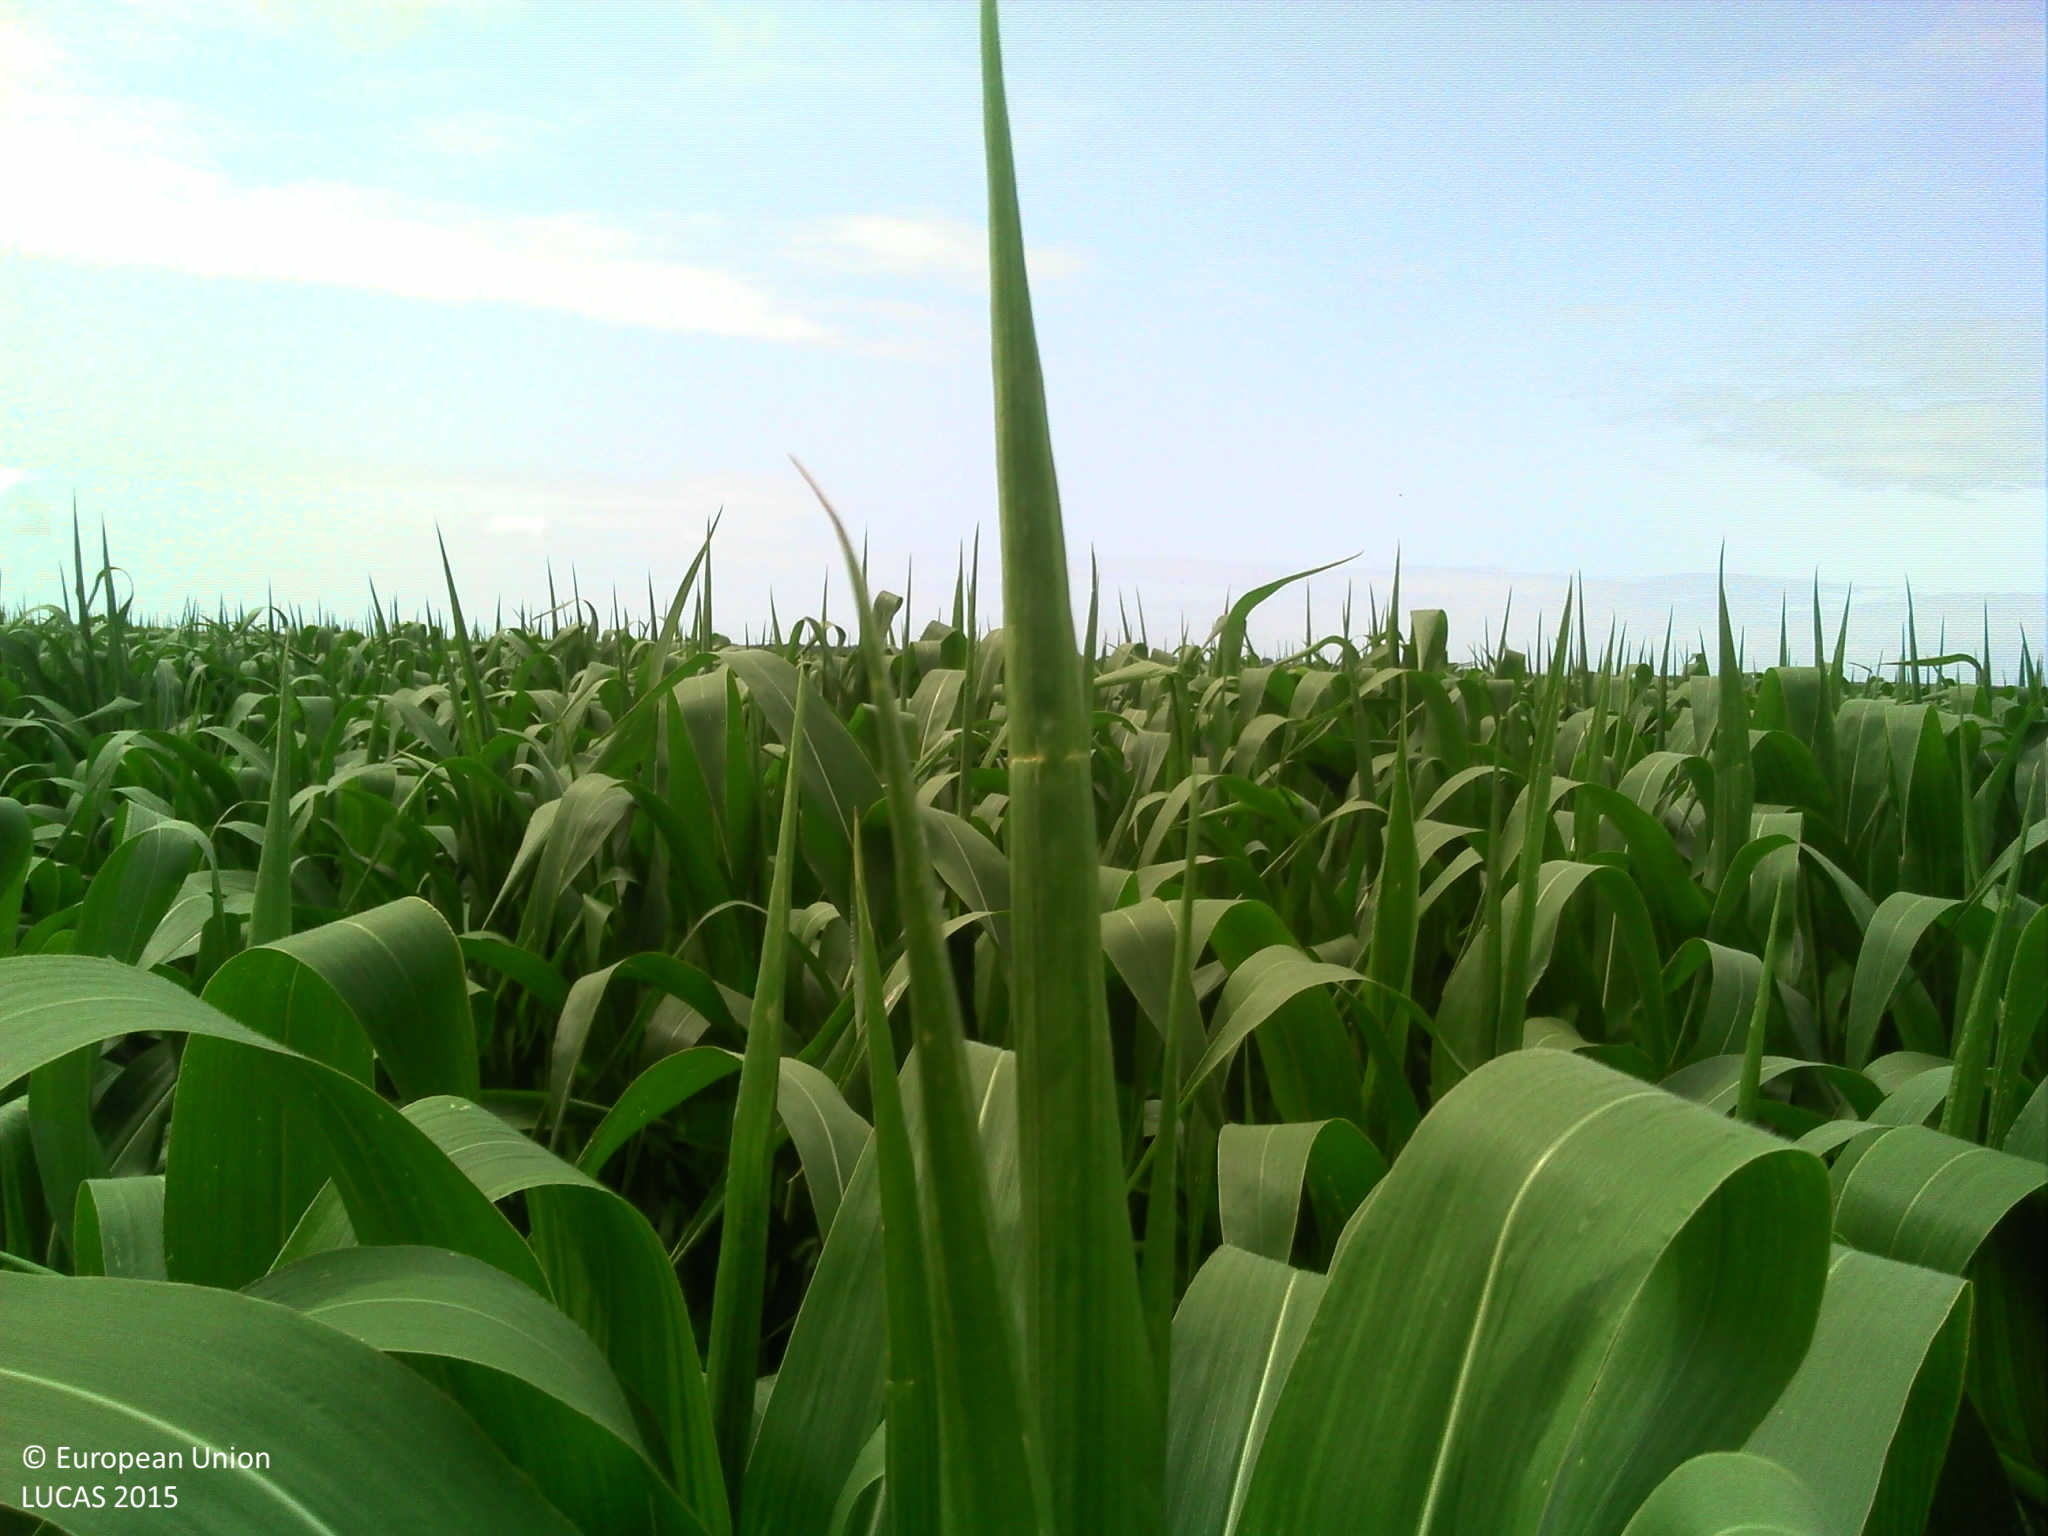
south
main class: Cropland
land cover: Maize
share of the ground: > 75 %
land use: Agriculture (excluding fallow land and kitchen gardens)
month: July
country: FR
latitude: 46.3830
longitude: -1.3343
